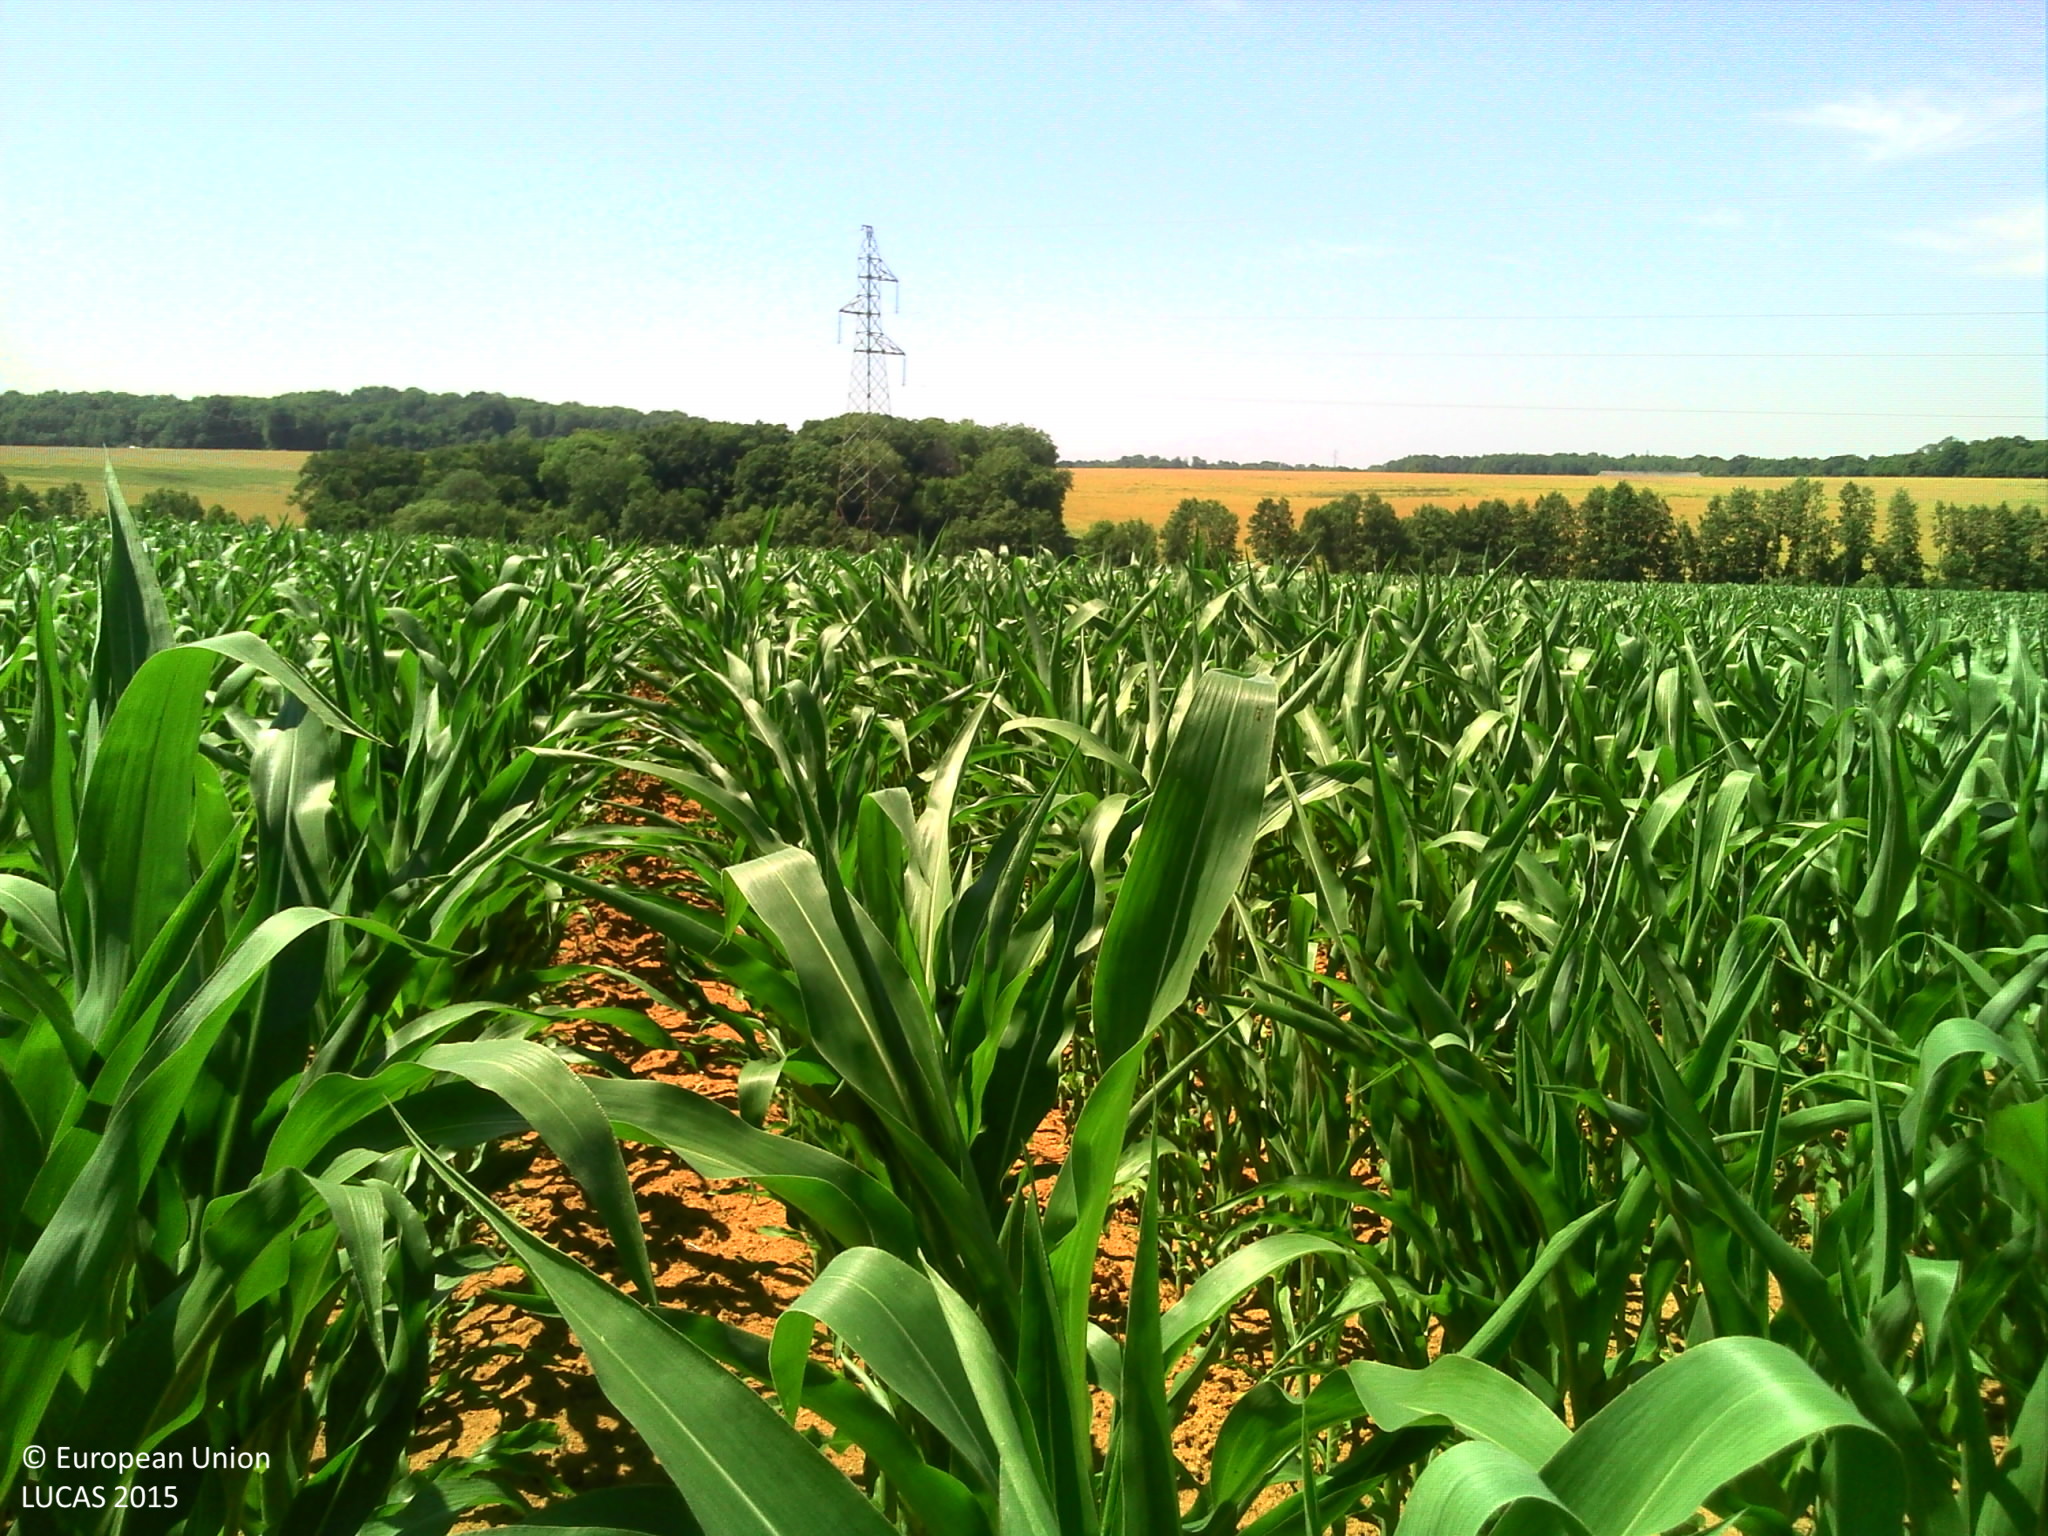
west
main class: Cropland
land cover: Maize
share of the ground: 50 - 75 %
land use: Agriculture (excluding fallow land and kitchen gardens)
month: July
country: FR
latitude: 48.8910
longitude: 5.1291
